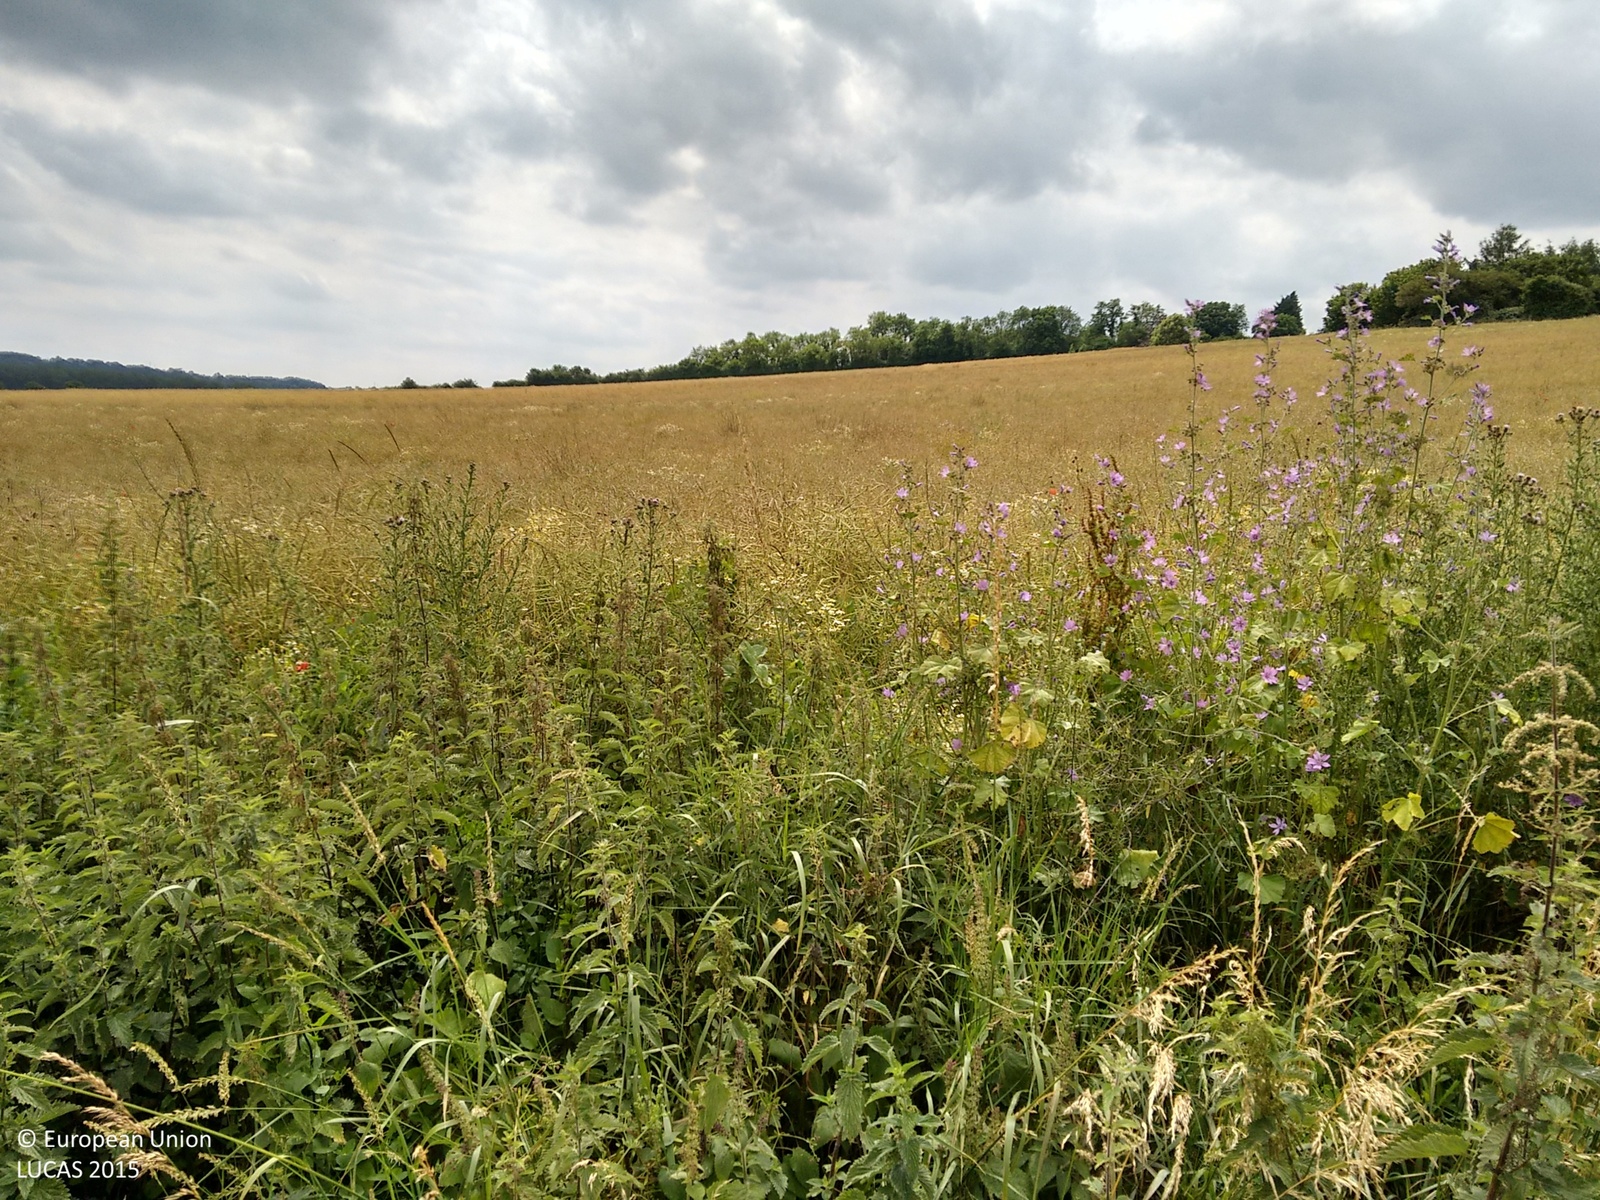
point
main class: Cropland
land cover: Rape and turnip rape
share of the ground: > 75 %
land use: Agriculture (excluding fallow land and kitchen gardens)
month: July
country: GB
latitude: 52.5222
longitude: -0.7558
